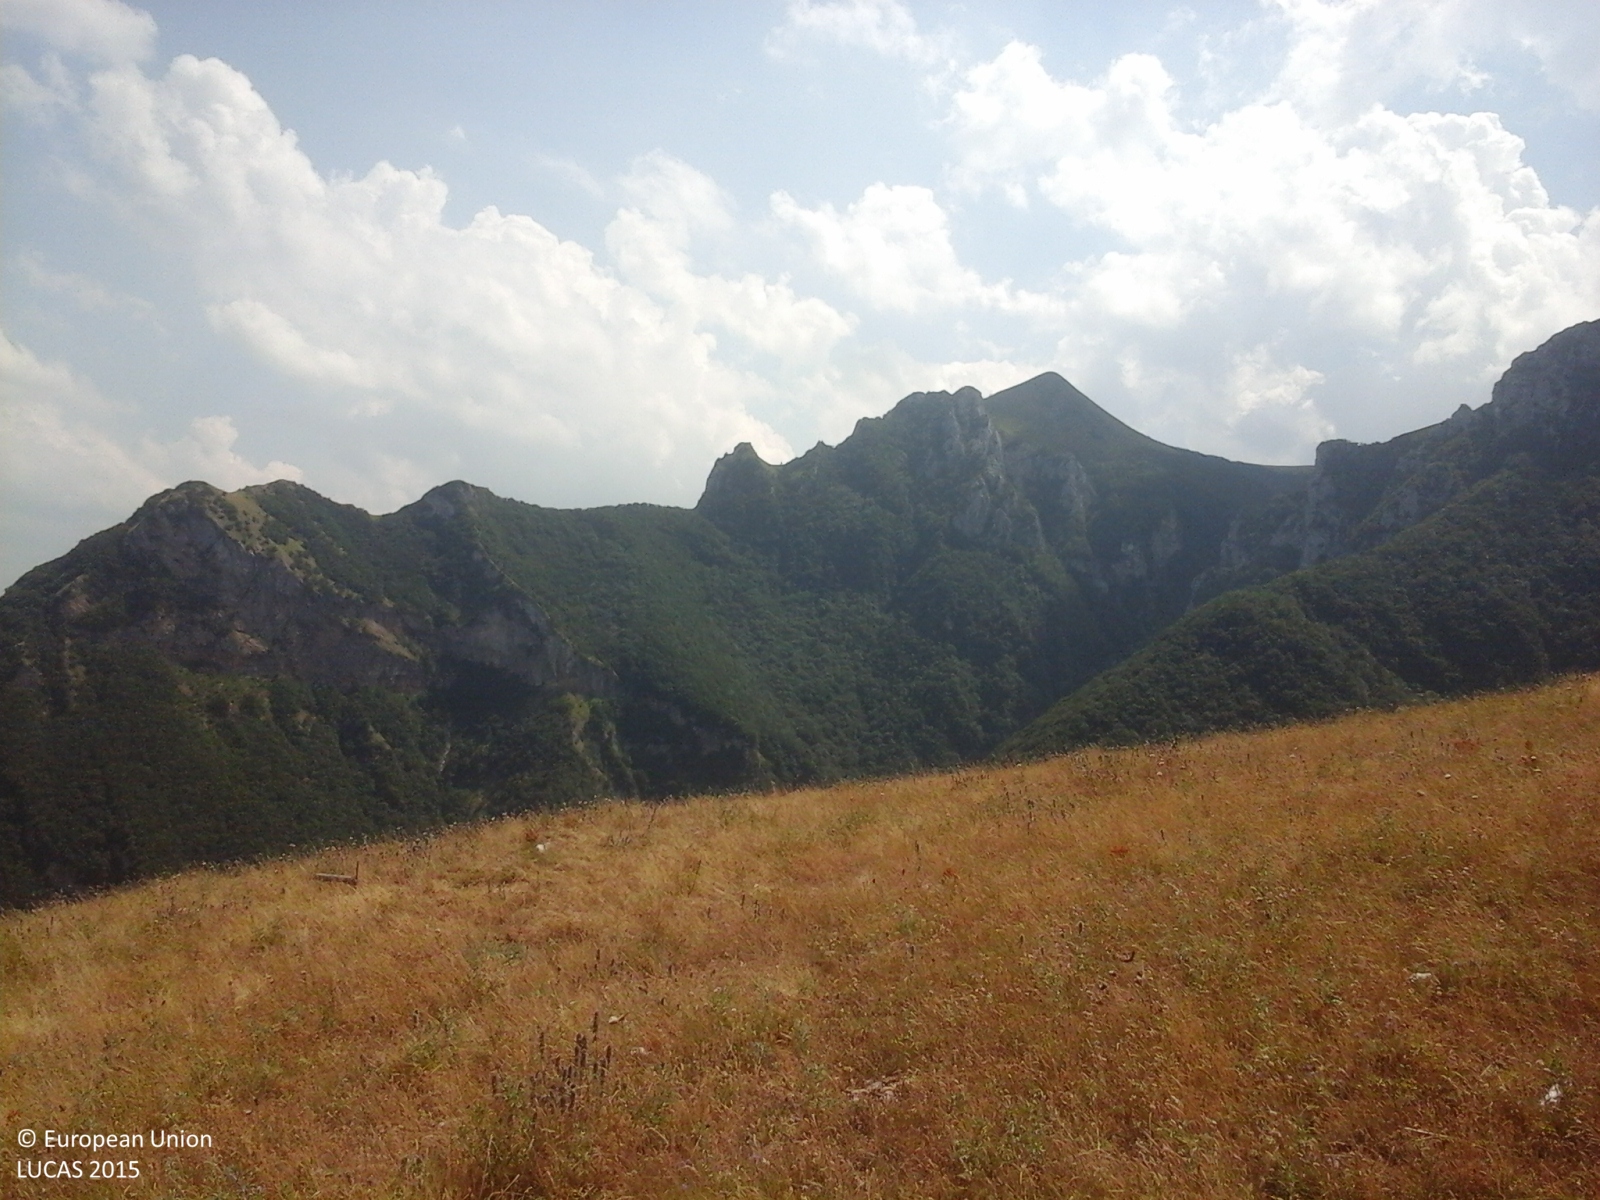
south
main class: Grassland
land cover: Grassland without tree/shrub cover
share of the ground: > 75 %
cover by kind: herbaceous plants 95 %, shrubs 5 %
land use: Agriculture (excluding fallow land and kitchen gardens)
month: July
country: IT
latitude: 43.0358
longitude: 13.2435
